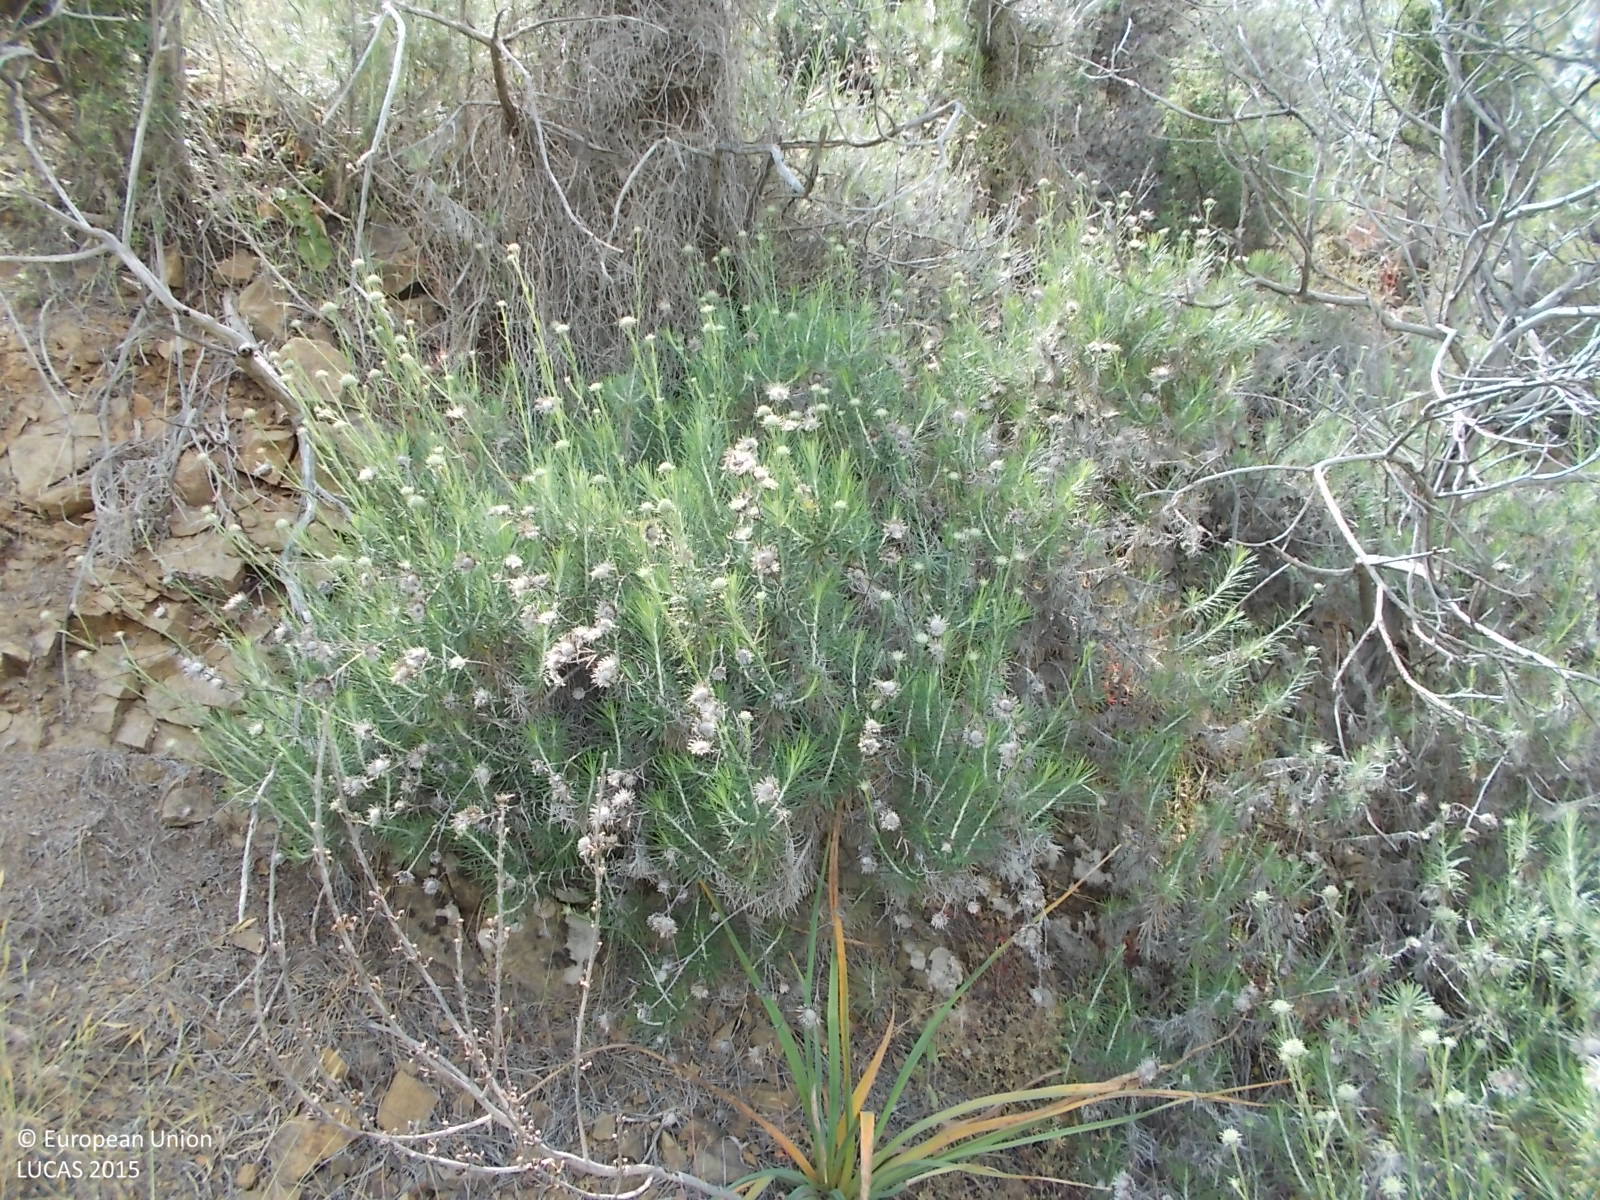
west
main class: Woodland
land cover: Pine dominated coniferous woodland
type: coniferous forest of the mediterranean region
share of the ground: > 75 %
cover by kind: coniferous forest trees 100 %
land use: Forestry
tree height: > 5 m
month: May
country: CY
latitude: 34.9622
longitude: 33.0756
